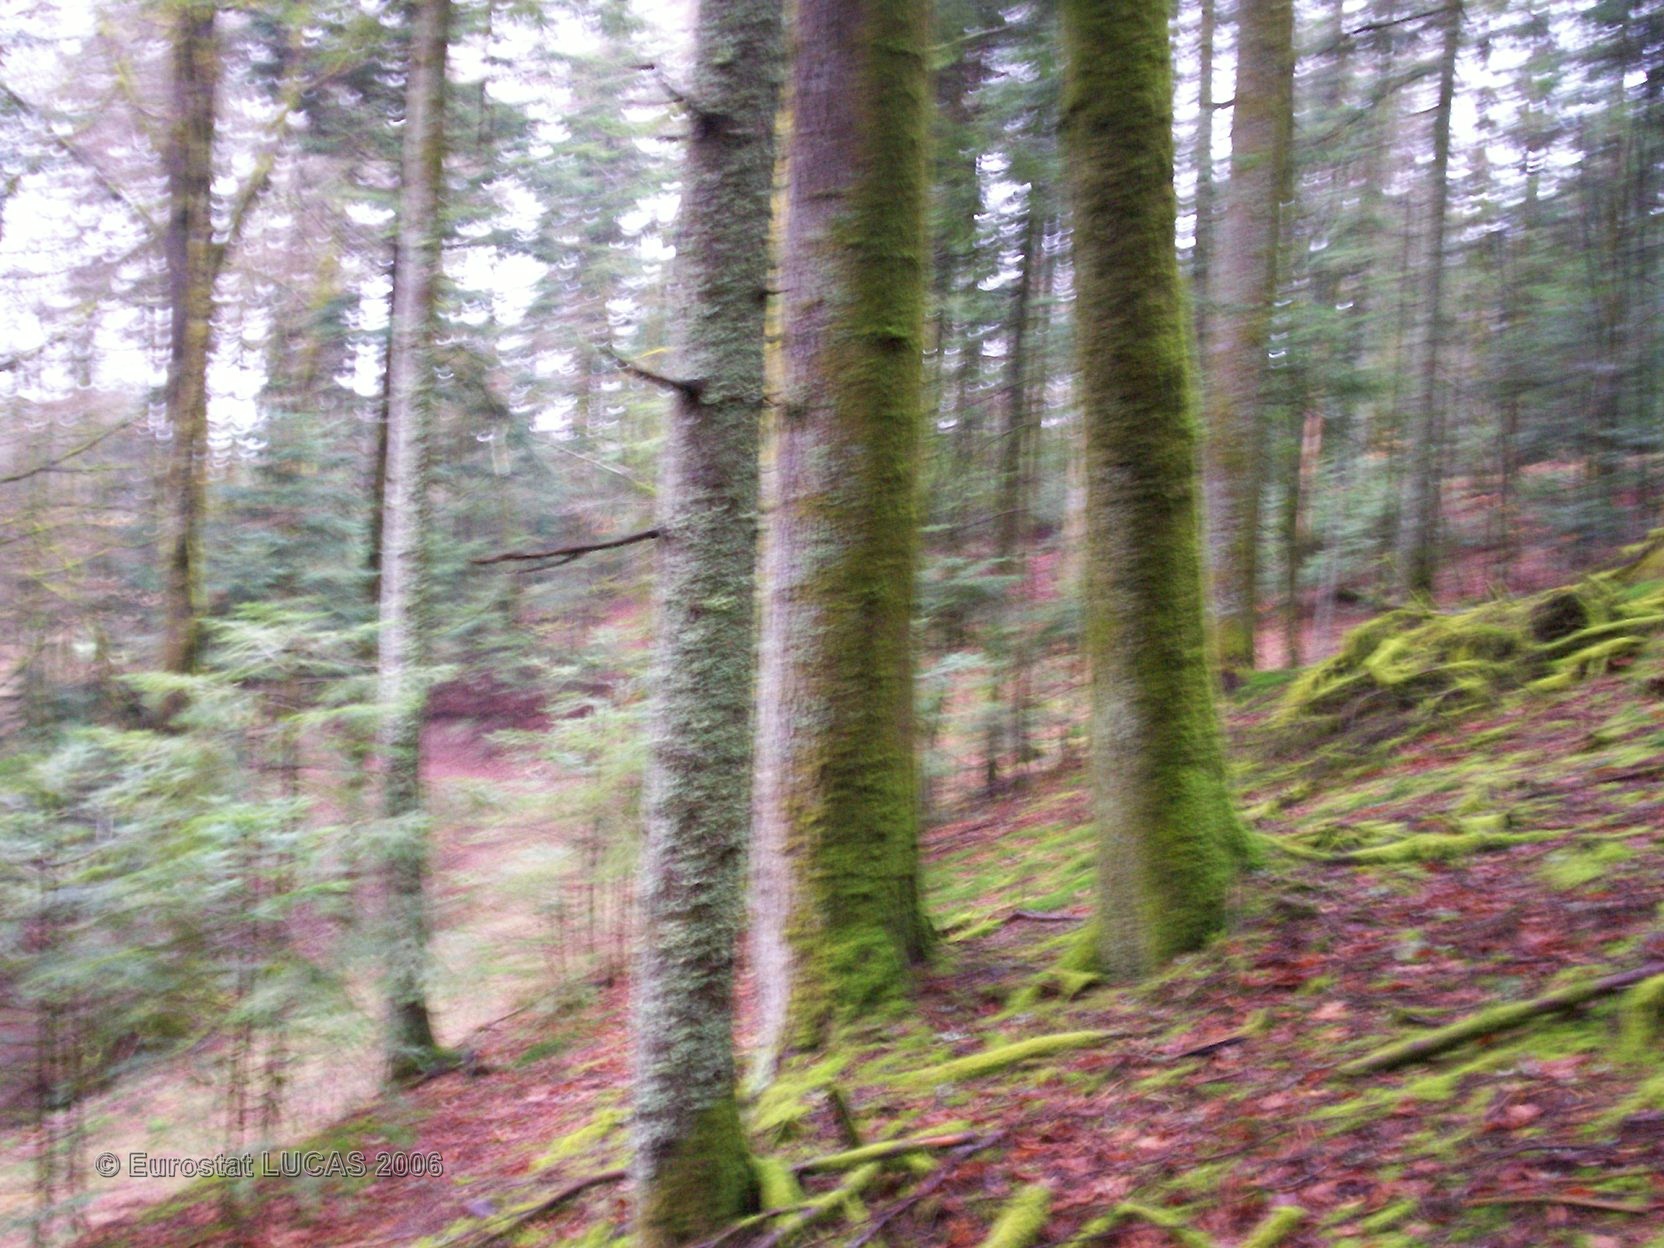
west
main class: Woodland
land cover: Coniferous forest
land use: Forestry
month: April
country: FR
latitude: 47.9897
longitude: 6.5572
